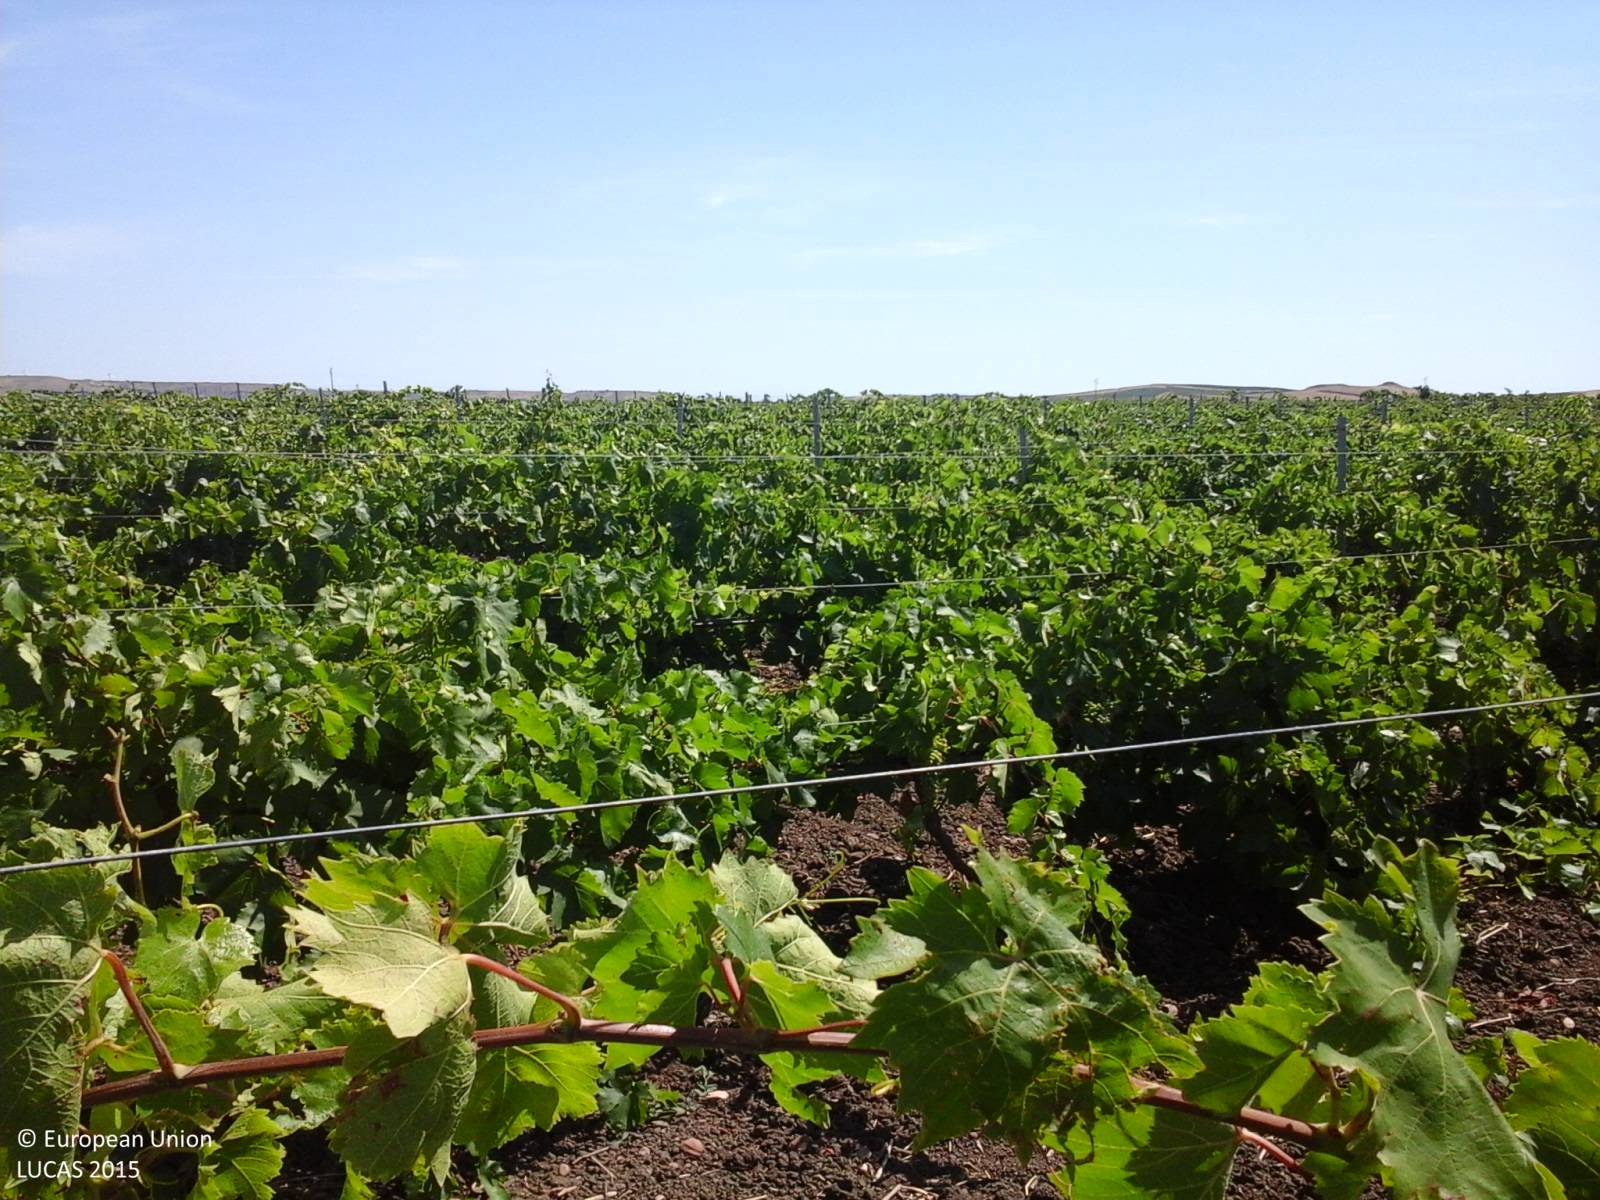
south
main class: Cropland
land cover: Vineyards
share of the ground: 25 - 50 %
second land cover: Other bare soil
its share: > 75 %
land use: Agriculture (excluding fallow land and kitchen gardens)
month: June
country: IT
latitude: 37.8396
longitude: 12.5830
